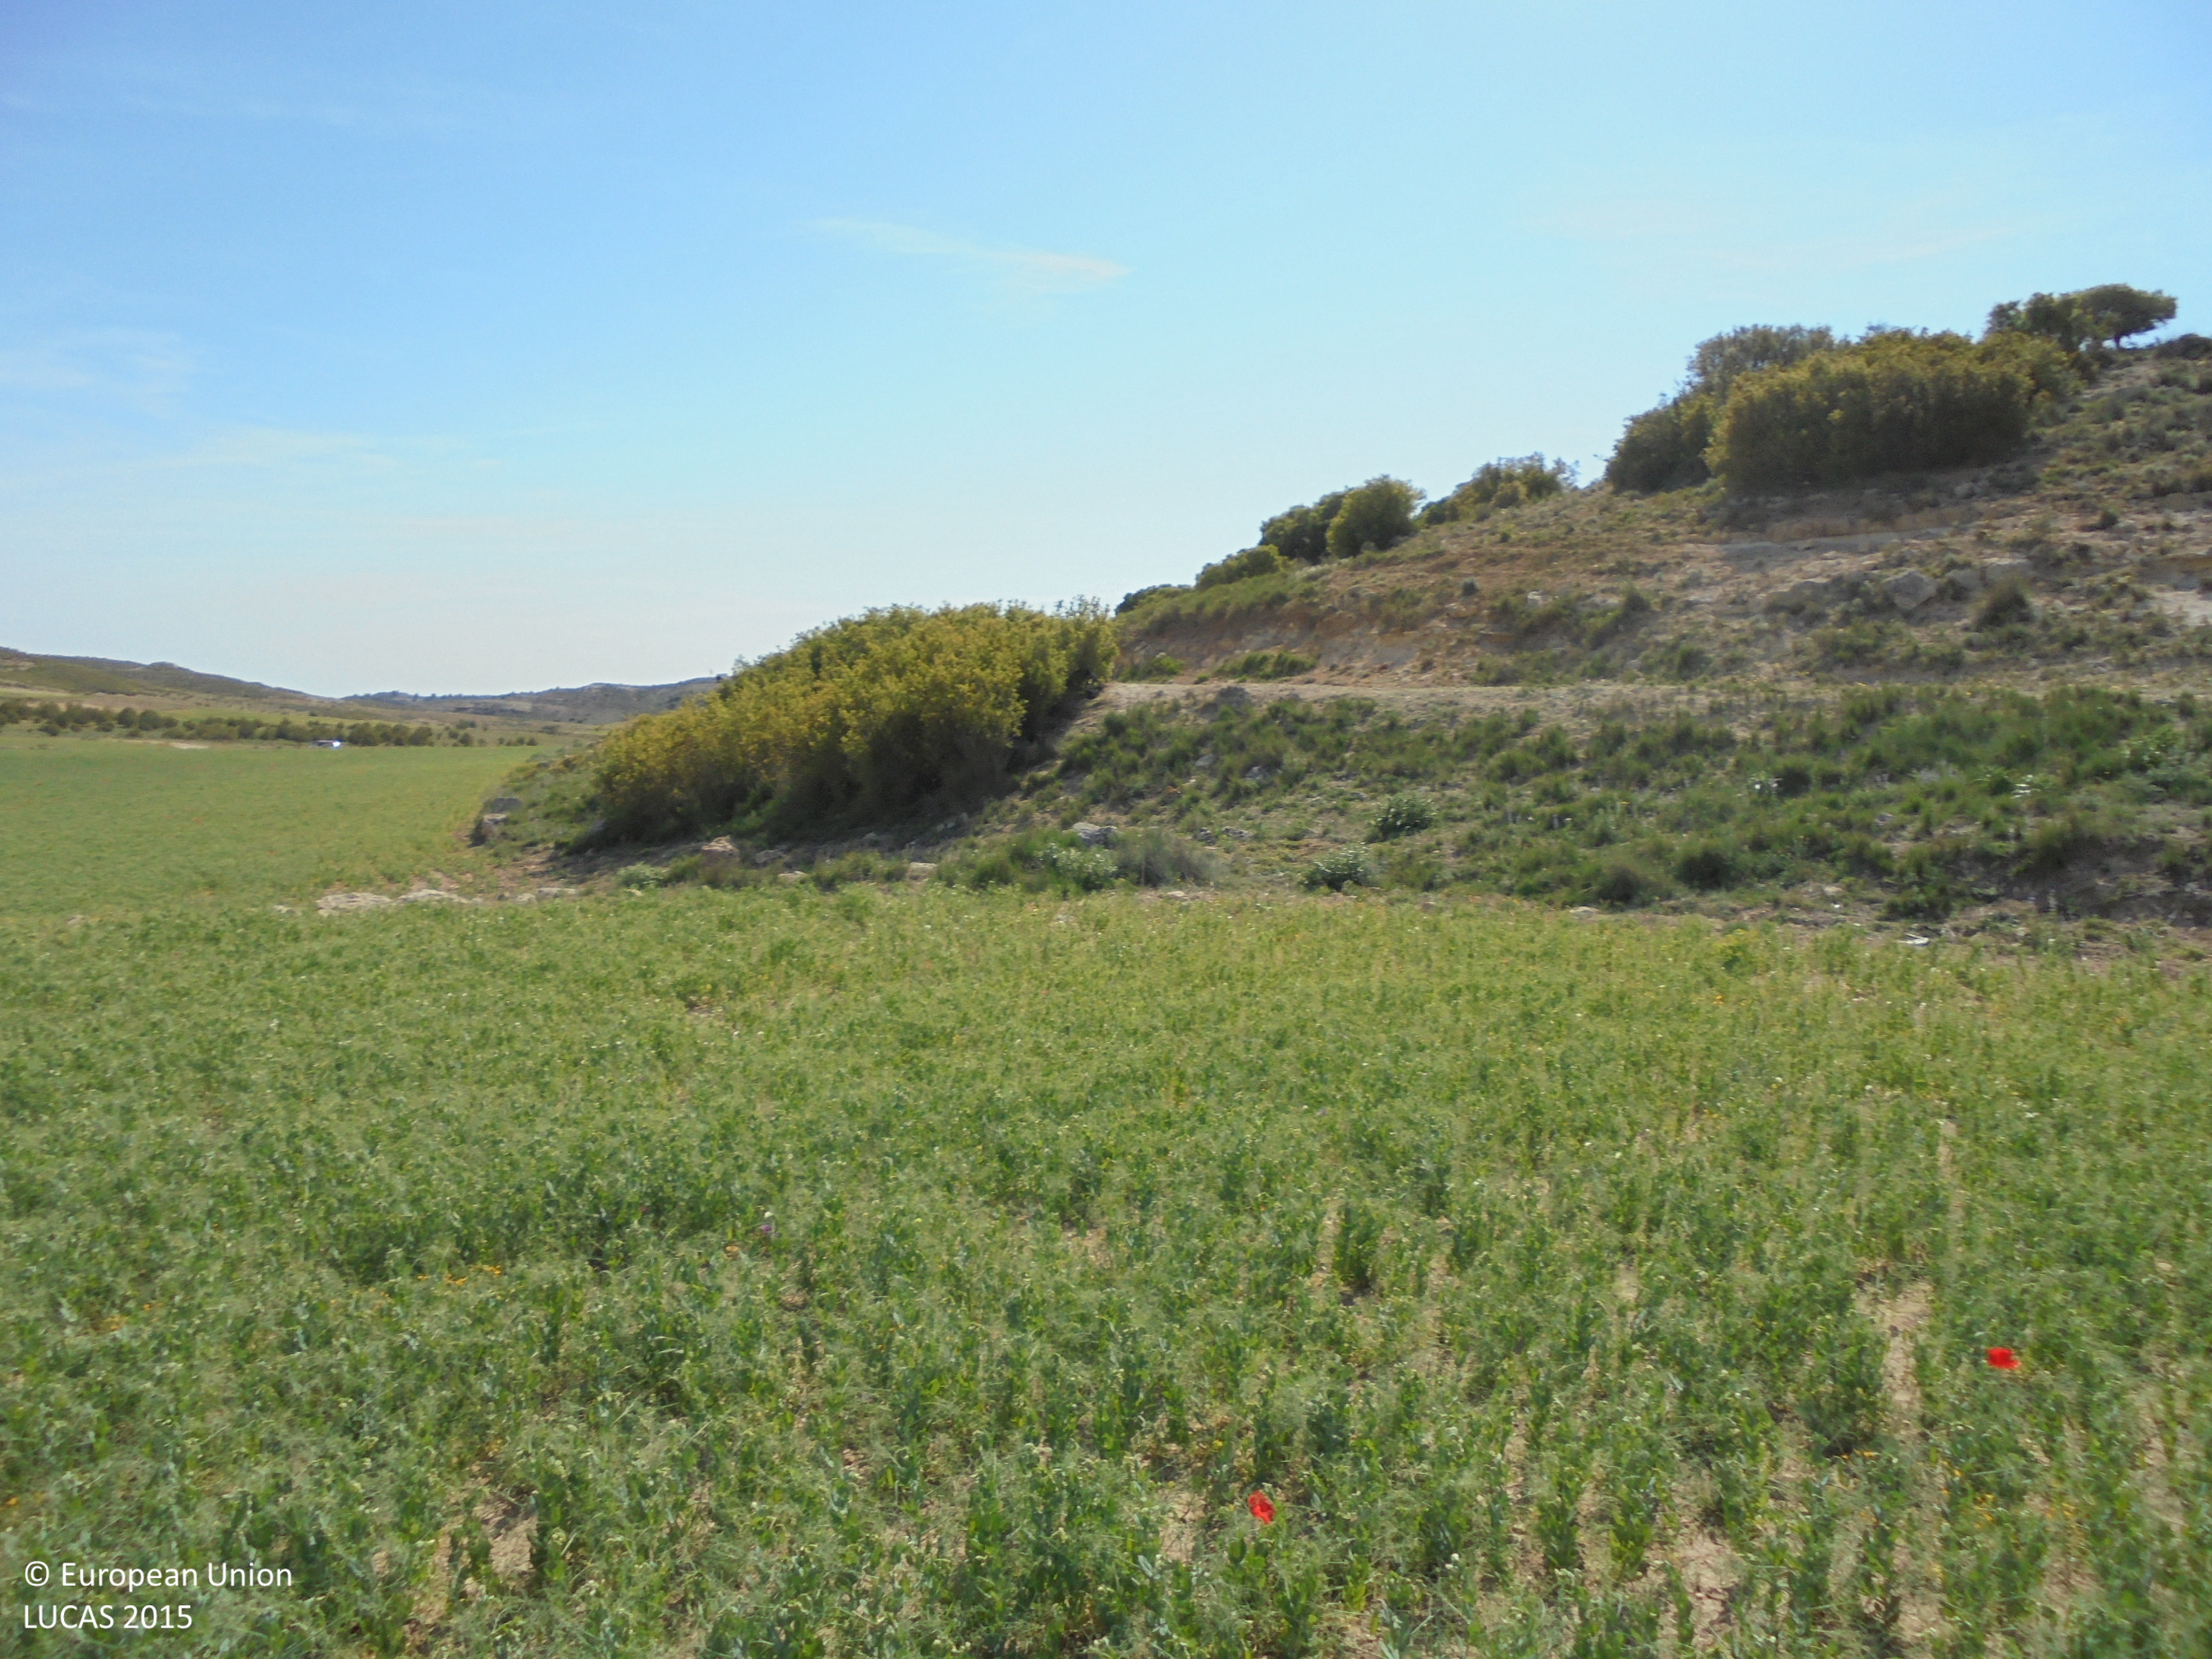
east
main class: Cropland
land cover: Dry pulses
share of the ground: 50 - 75 %
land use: Agriculture (excluding fallow land and kitchen gardens)
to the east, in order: Dry pulses; Grass margins; Dry stone walls; Shrubland without tree cover; Tracks; Shrubland with sparse tree cover; Broadleaved woodland; Shrubland with sparse tree cover
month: May
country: ES
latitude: 39.1461
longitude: -1.5359
